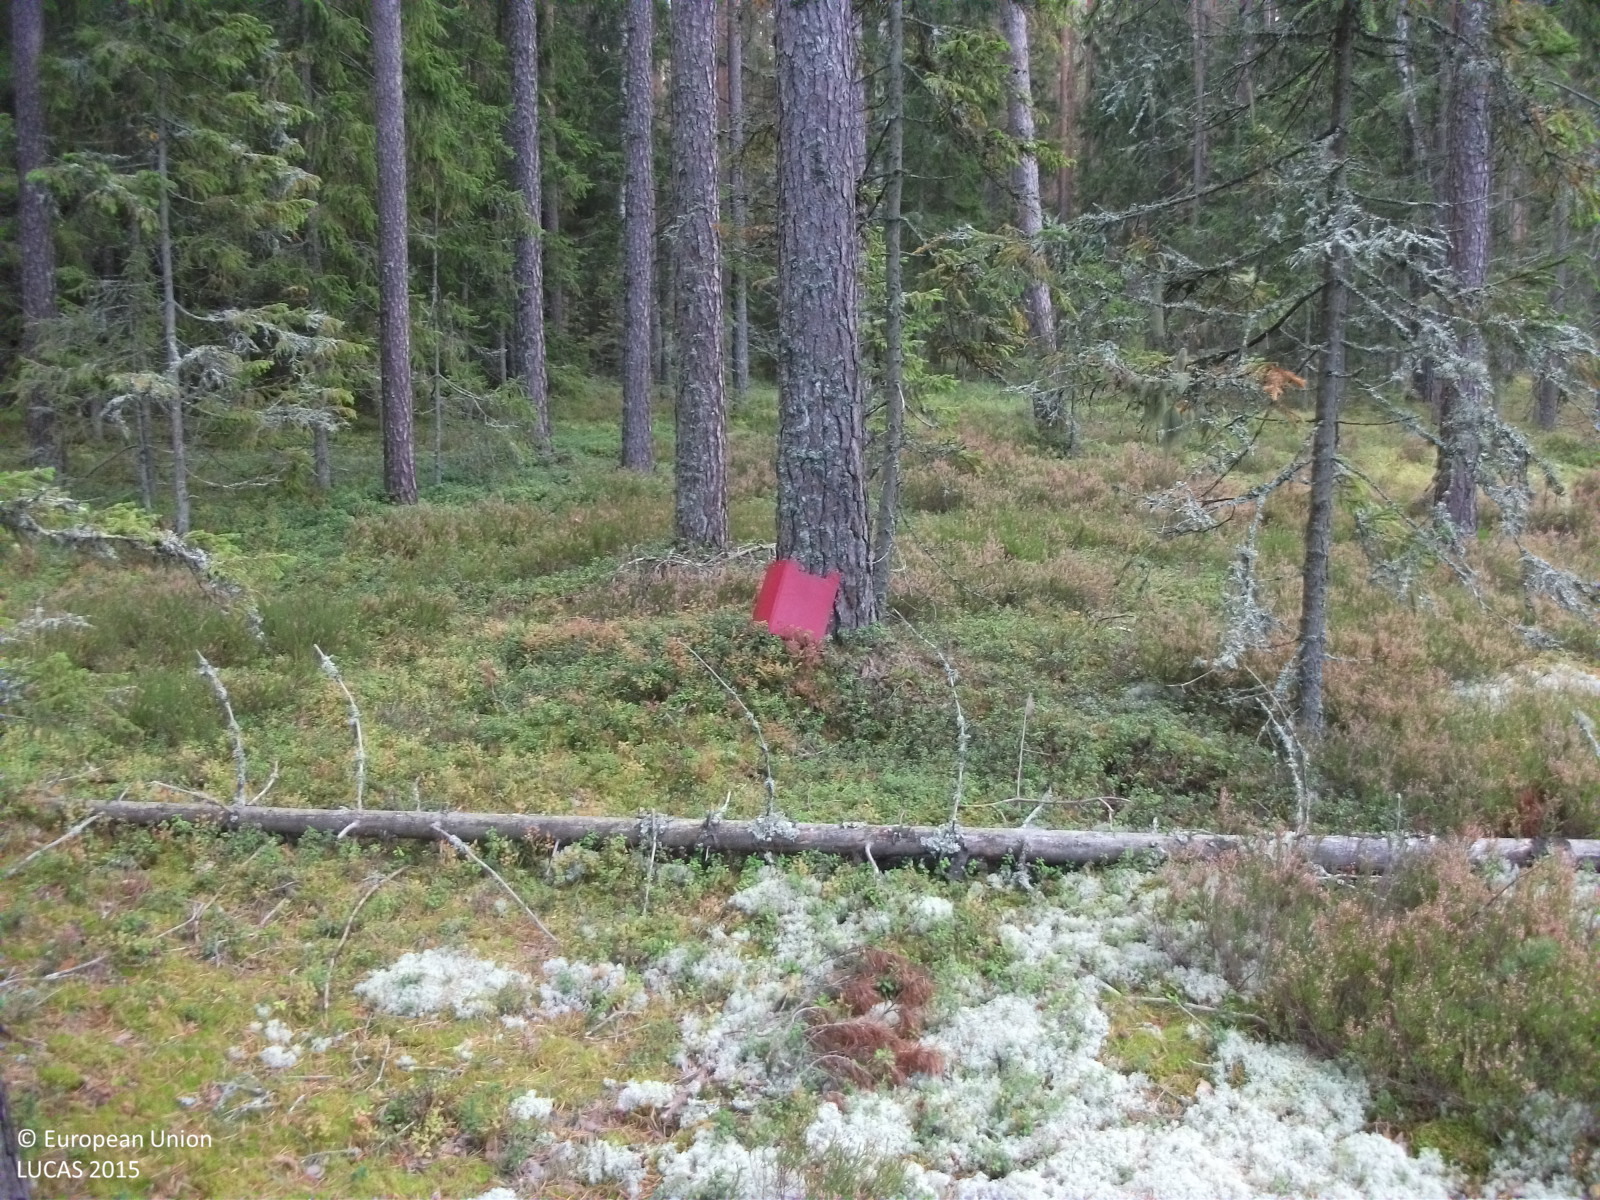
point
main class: Woodland
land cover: Pine dominated coniferous woodland
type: hemiboreal forest and nemoral coniferous forest and mixed broadleaved-coniferous forest
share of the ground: > 75 %
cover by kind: coniferous forest trees 80 %, lichens and mosses 15 %, herbaceous plants 5 %
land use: Forestry
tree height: > 5 m
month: September
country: LV
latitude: 57.6876
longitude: 24.4640
